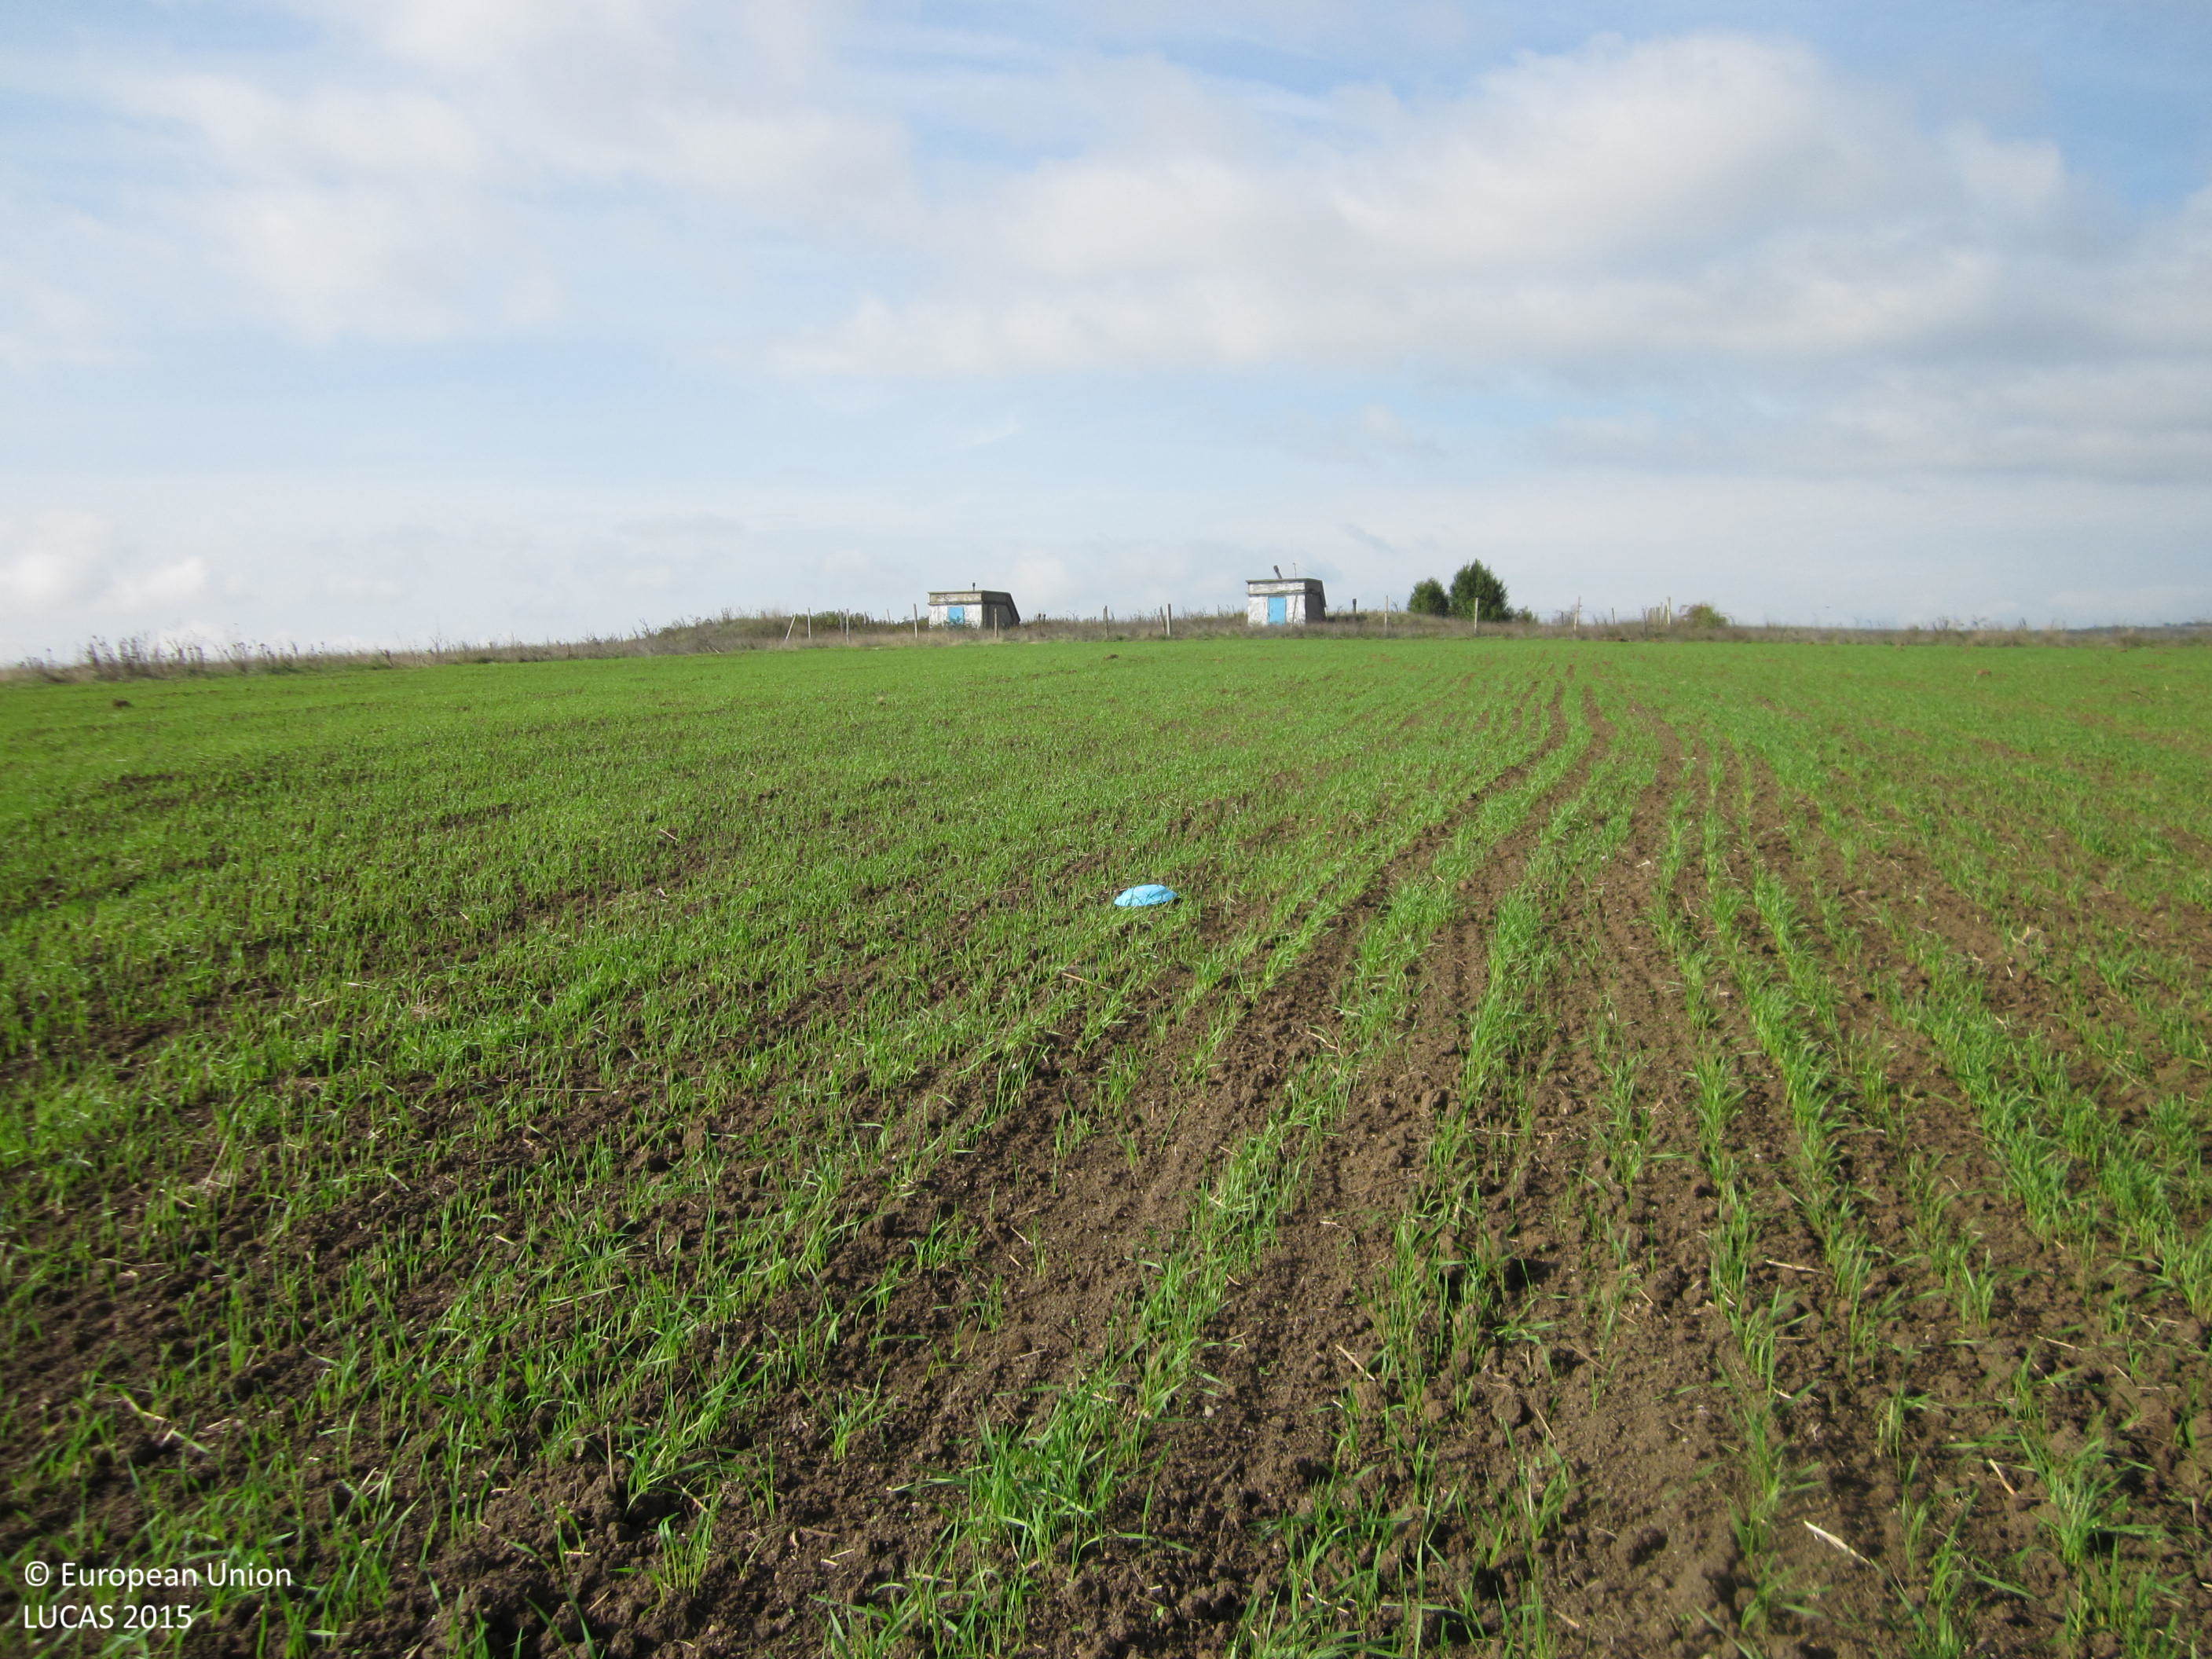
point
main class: Cropland
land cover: Common wheat
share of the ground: 25 - 50 %
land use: Agriculture (excluding fallow land and kitchen gardens)
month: October
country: BG
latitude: 42.6909
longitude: 26.8120
